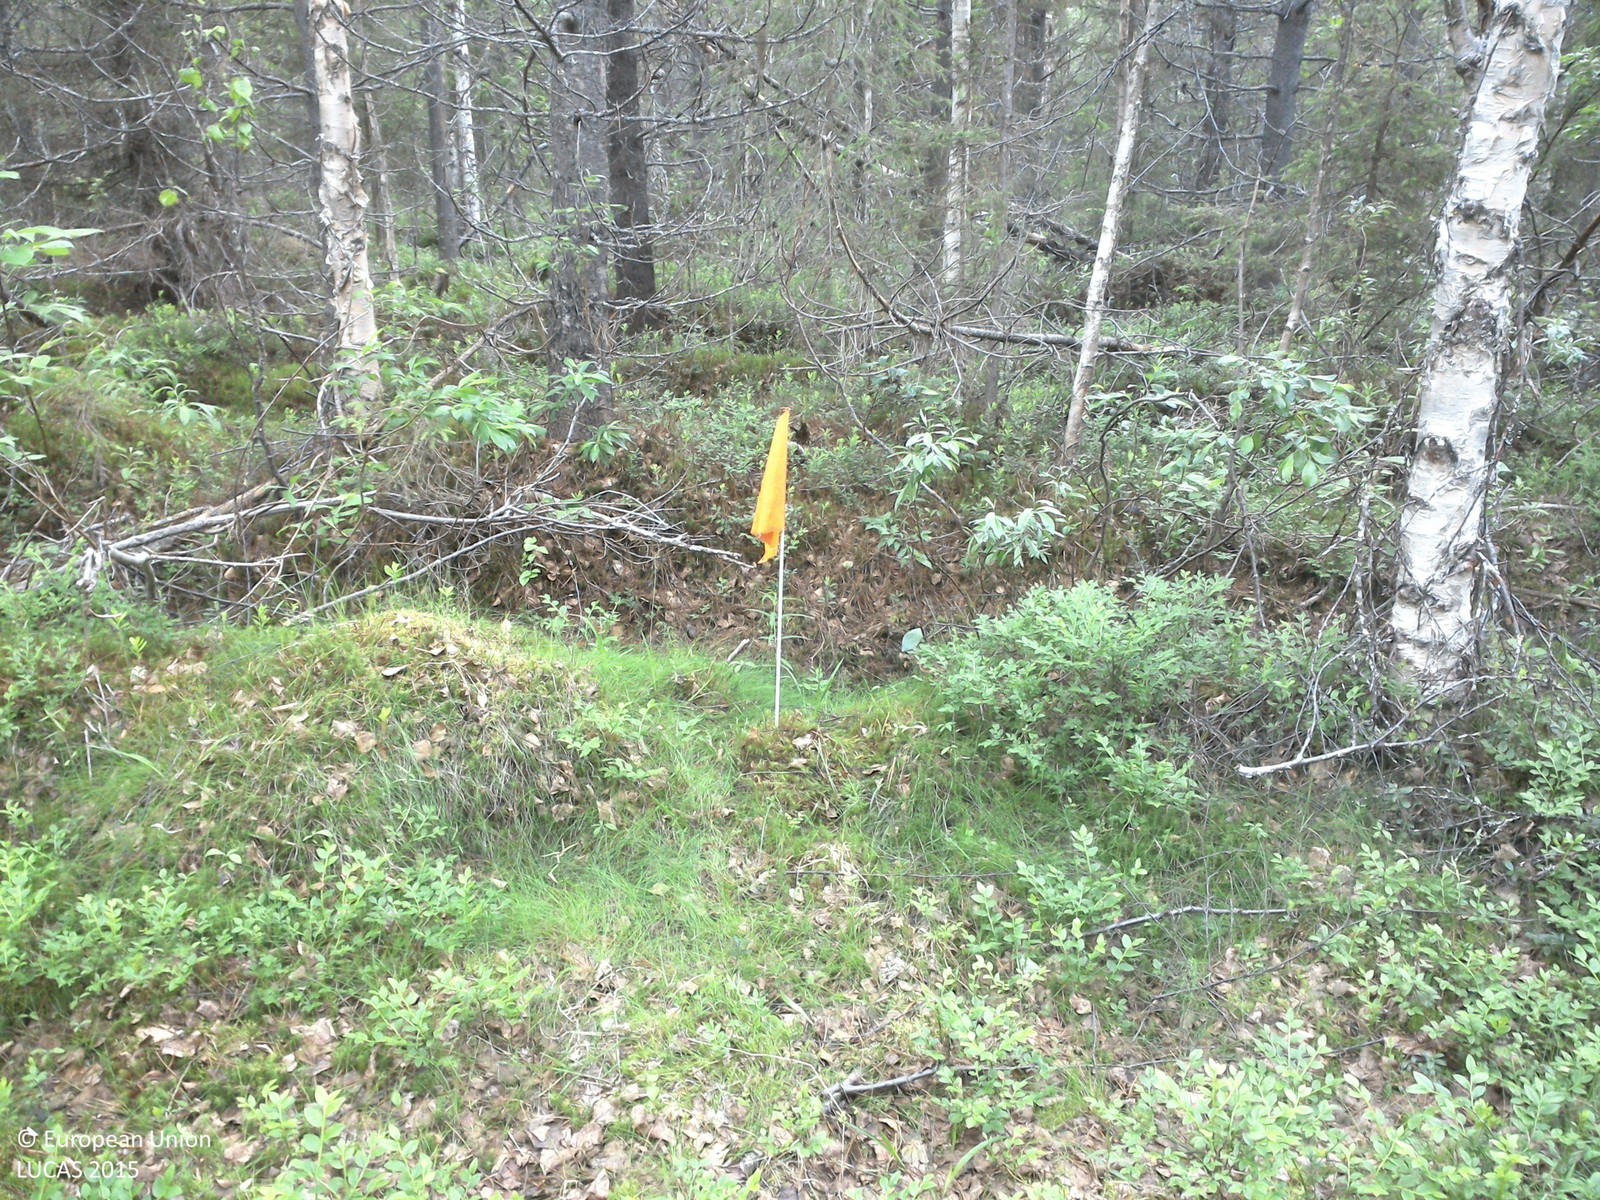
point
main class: Woodland
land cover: Pine dominated mixed woodland
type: exotic forest
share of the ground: 25 - 50 %
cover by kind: shrubs 55 %, coniferous forest trees 25 %, broadleaved forest trees 10 %, lichens and mosses 10 %
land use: Forestry
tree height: > 5 m
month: July
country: SE
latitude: 66.7564
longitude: 23.5833
